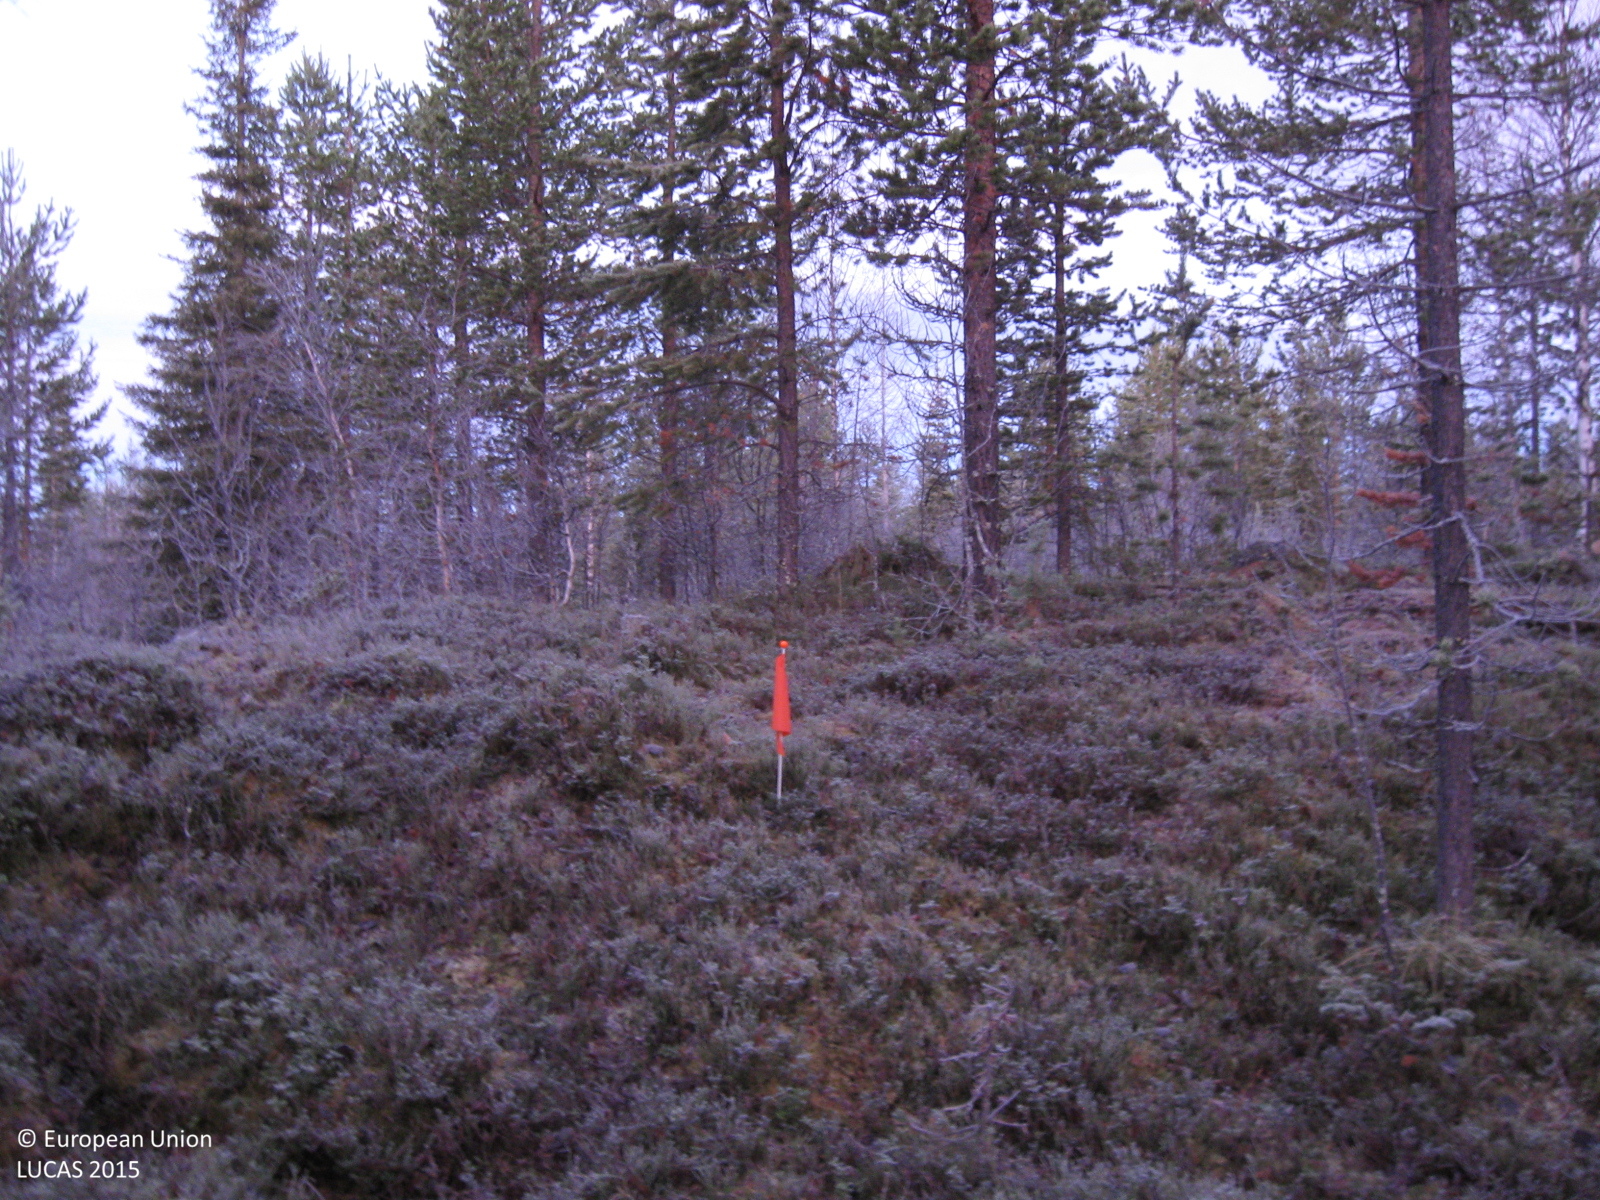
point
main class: Woodland
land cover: Pine dominated mixed woodland
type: boreal forest
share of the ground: 25 - 50 %
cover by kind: coniferous forest trees 25 %, shrubs 25 %, broadleaved forest trees 20 %, herbaceous plants 15 %, lichens and mosses 15 %
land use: Forestry
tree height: > 5 m
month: October
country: SE
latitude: 66.6215
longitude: 21.1375
